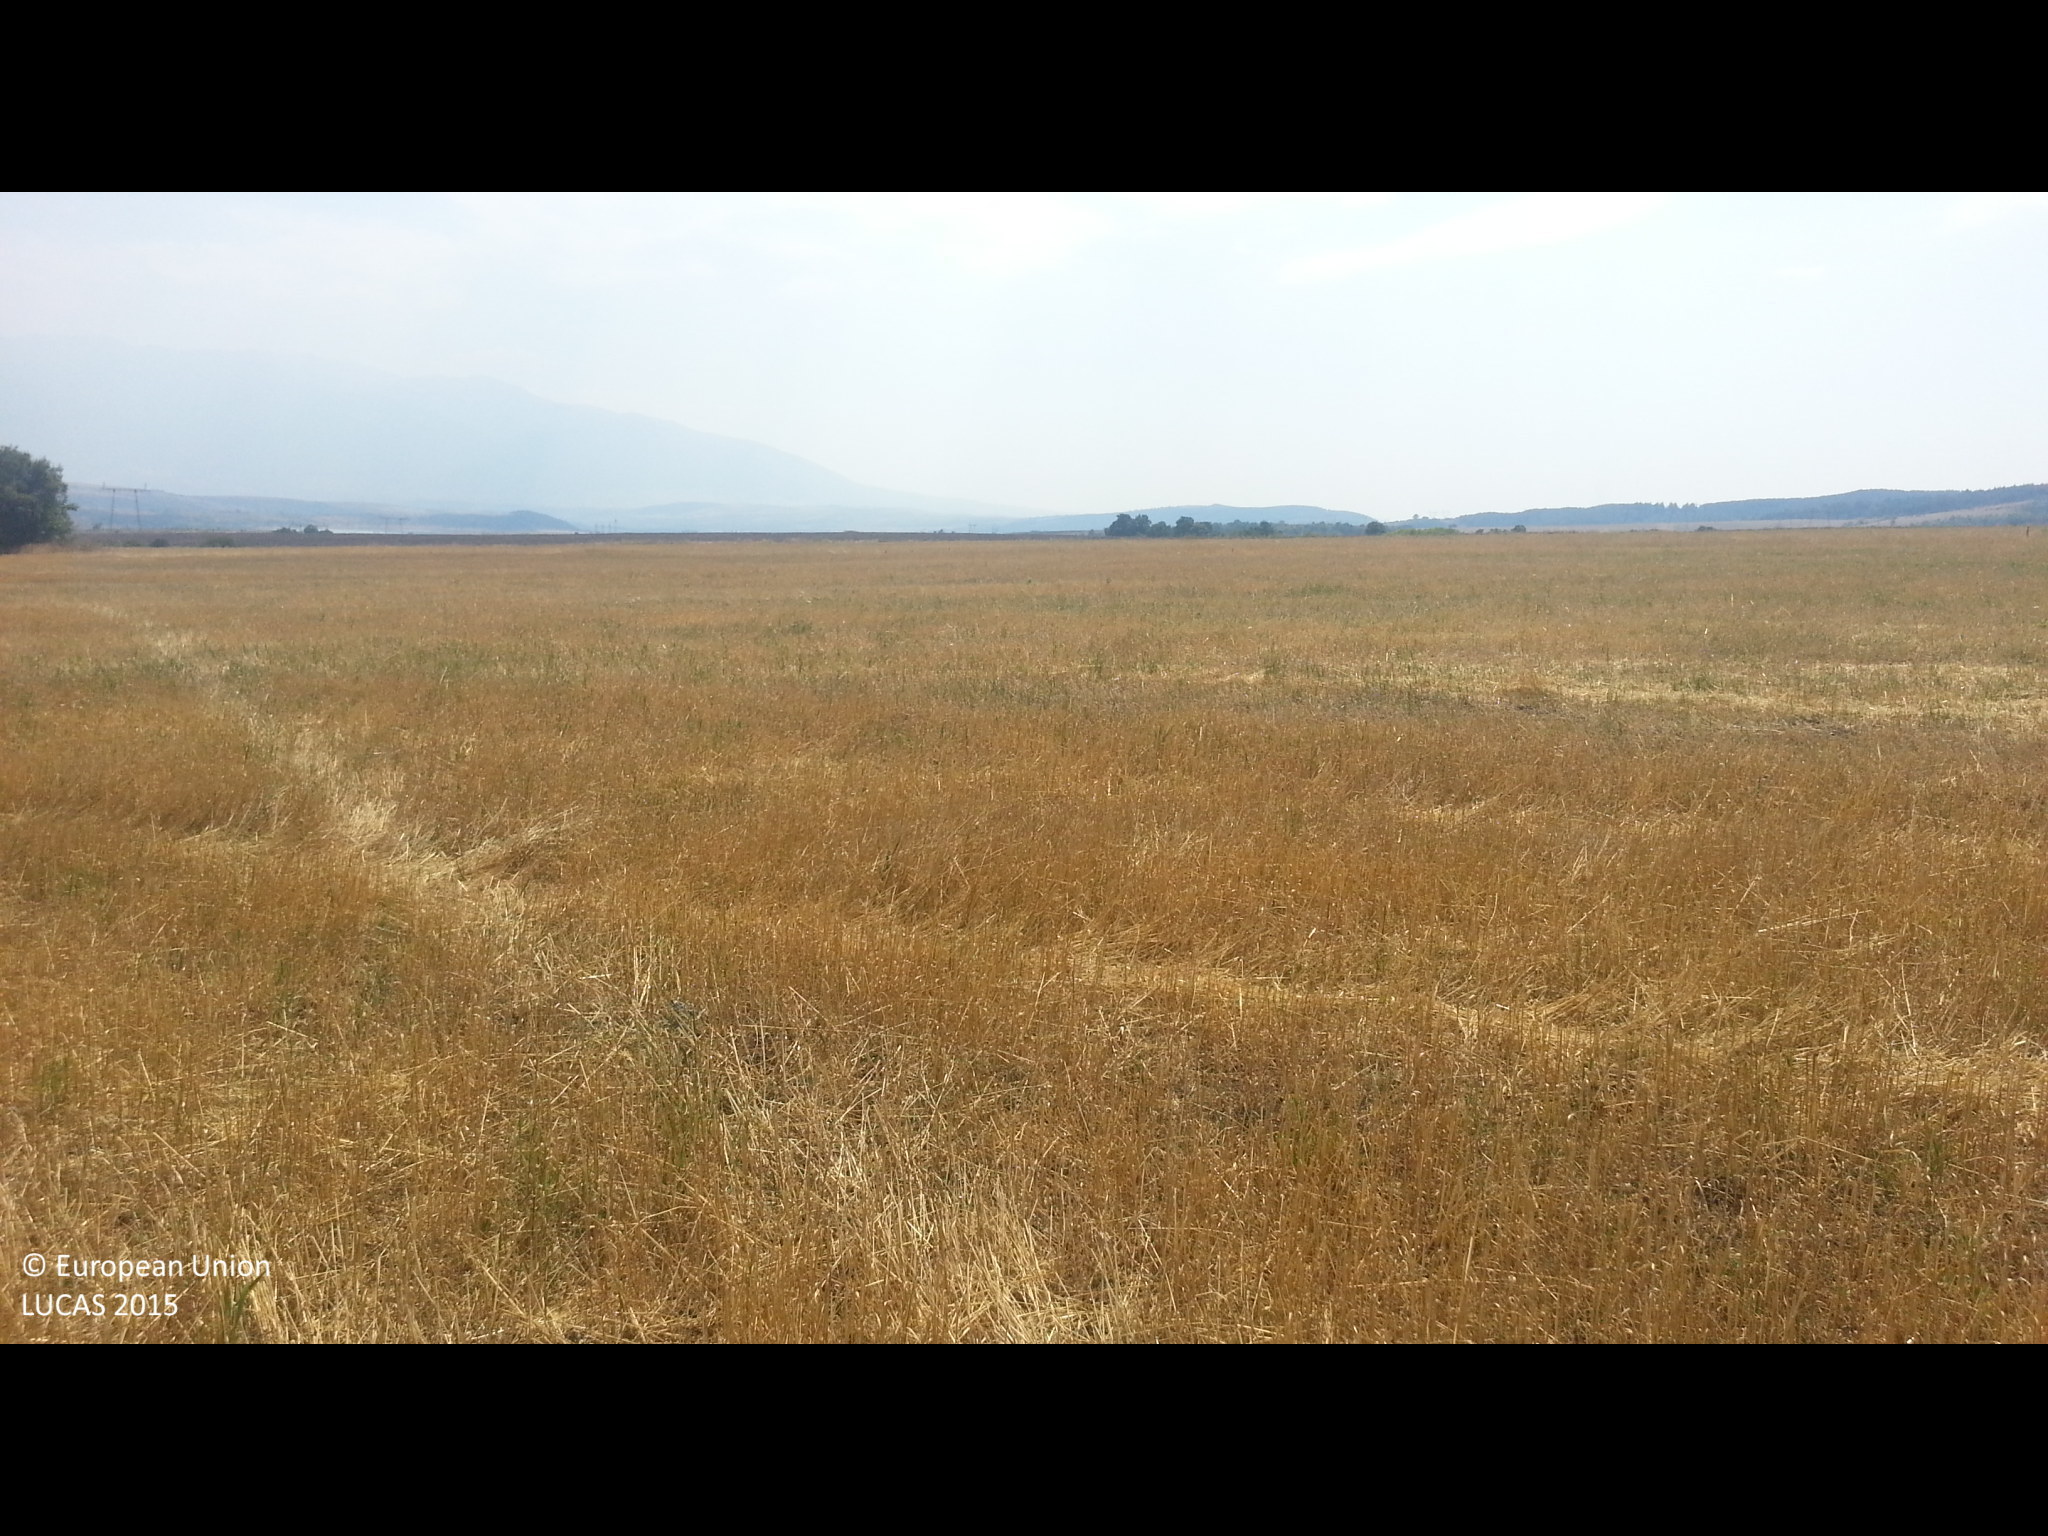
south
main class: Cropland
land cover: Common wheat
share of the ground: > 75 %
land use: Agriculture (excluding fallow land and kitchen gardens)
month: August
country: BG
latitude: 42.3889
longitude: 23.0613
